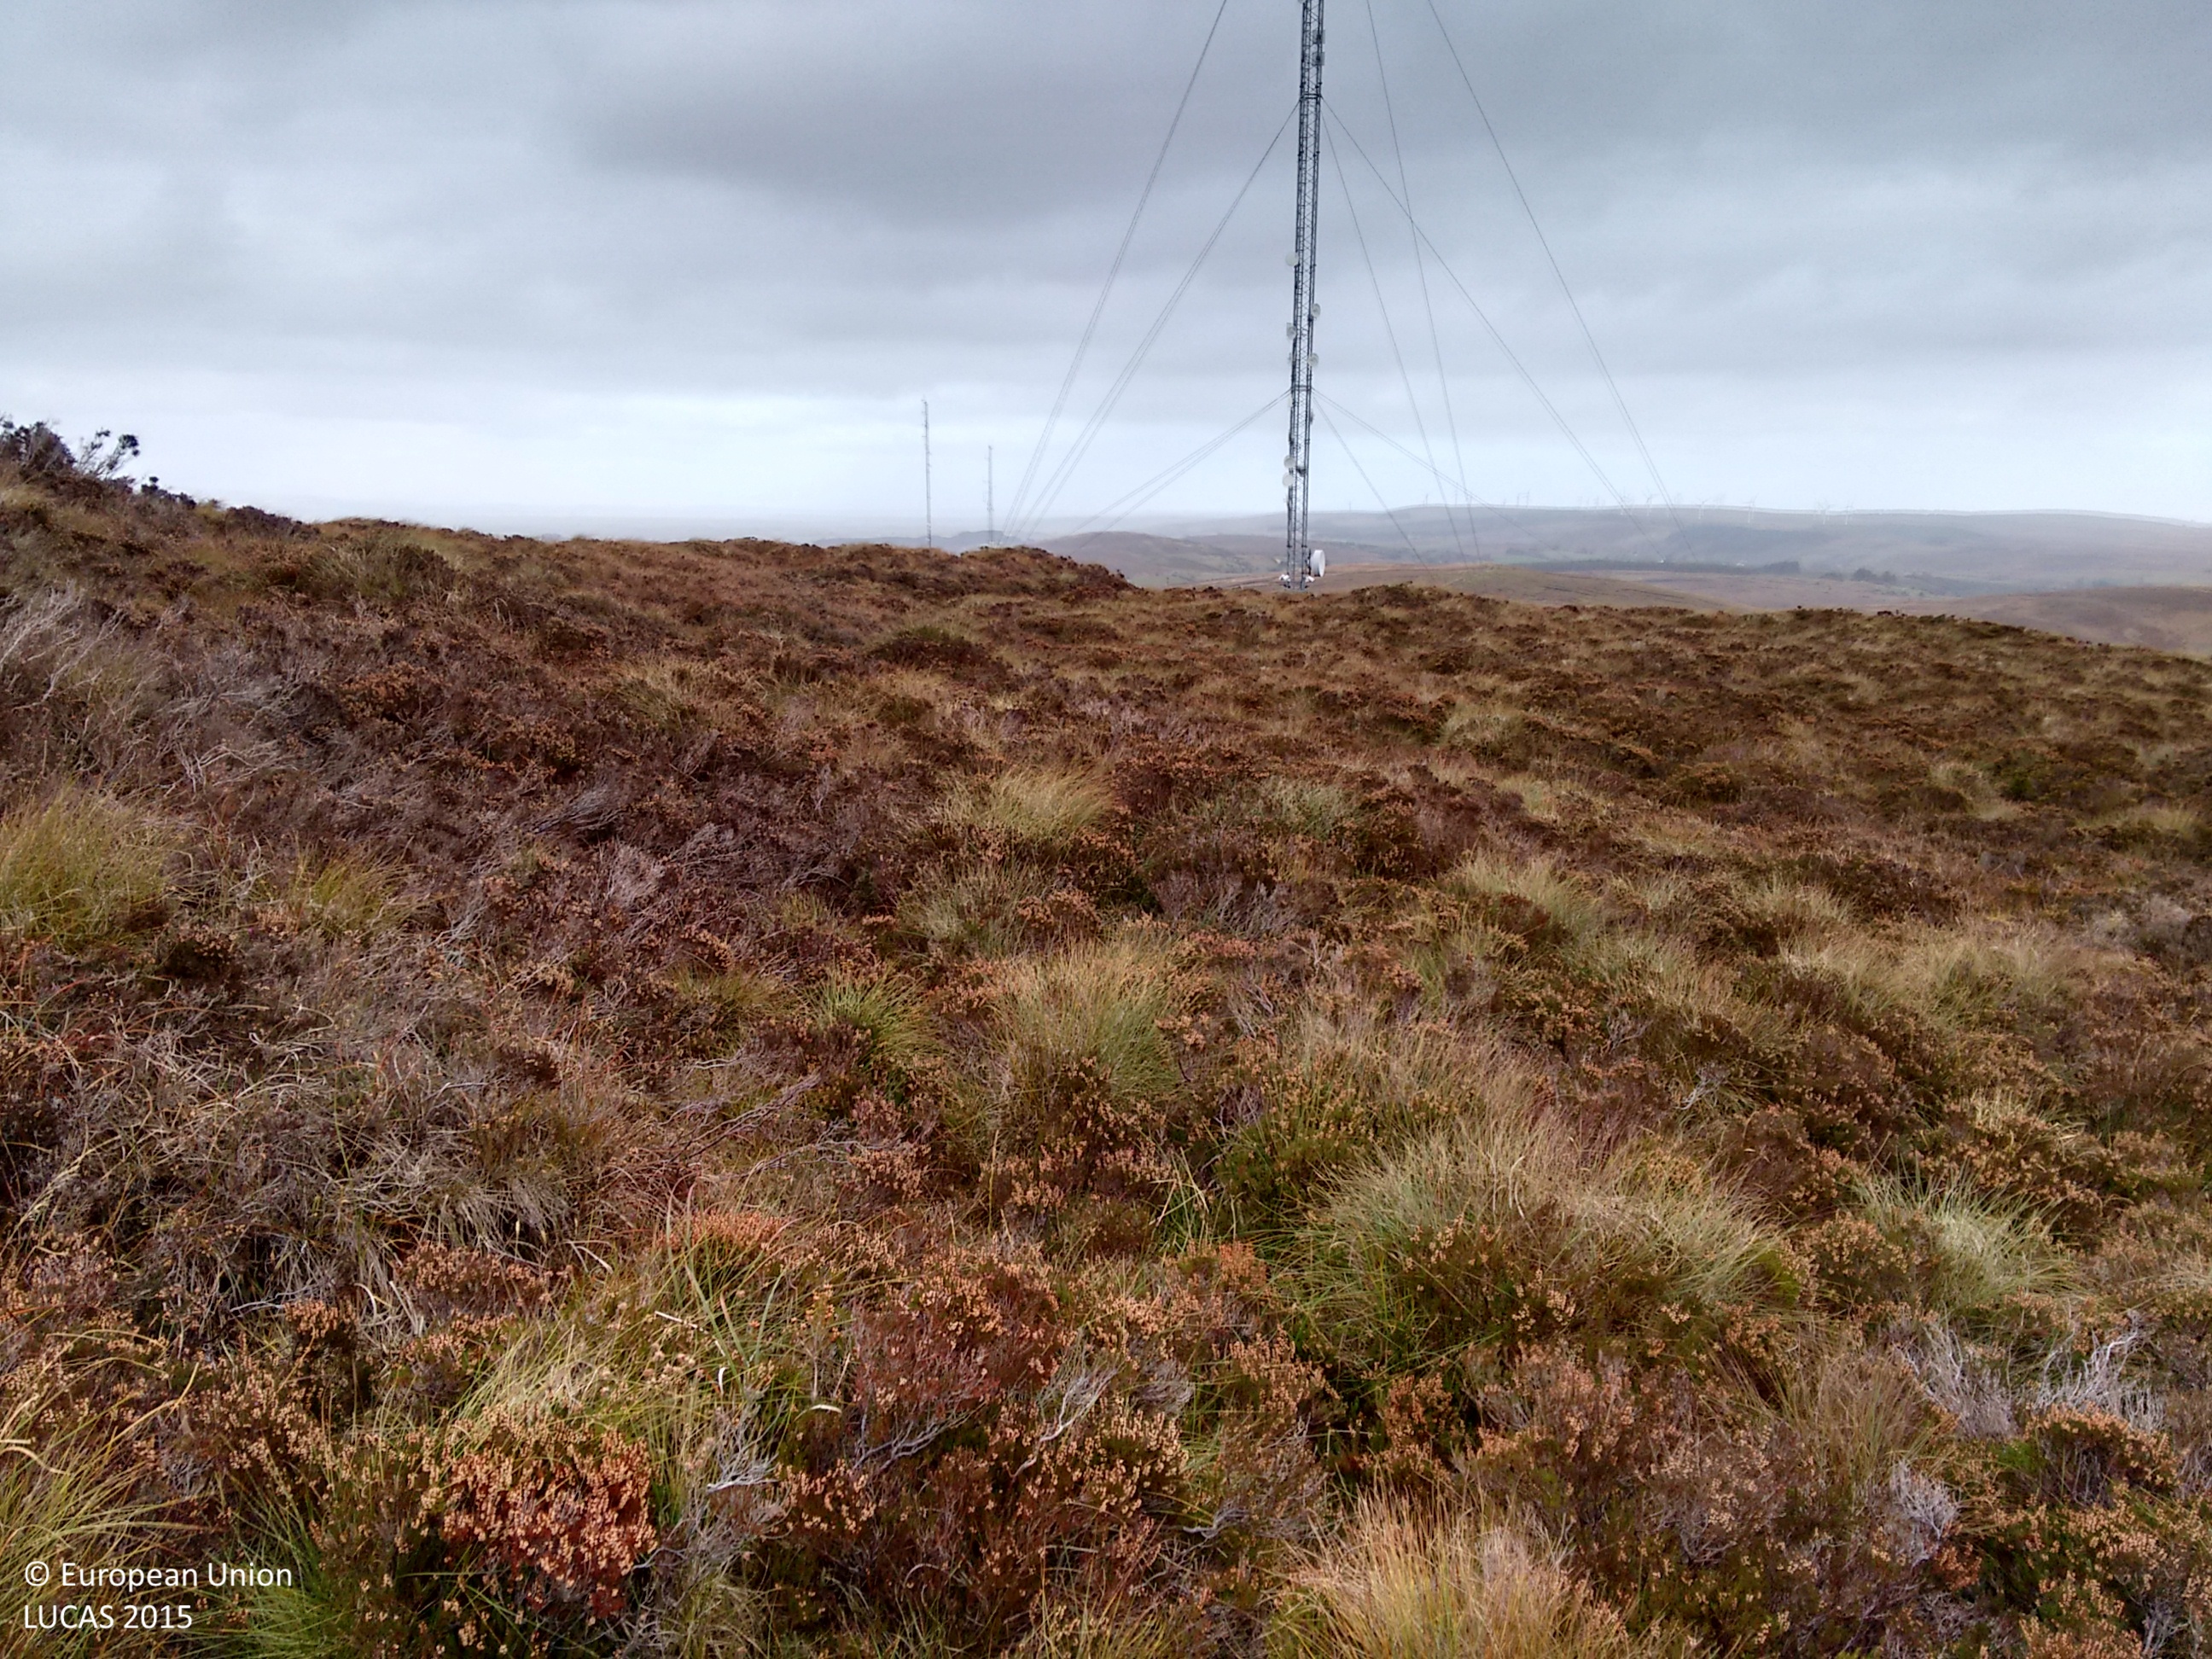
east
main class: Shrubland
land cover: Shrubland without tree cover
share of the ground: > 75 %
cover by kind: shrubs 80 %, lichens and mosses 20 %
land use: Agriculture (excluding fallow land and kitchen gardens)
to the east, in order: Shrubland without tree cover; Fences; Shrubland without tree cover; Fences; Grassland without tree/shrub cover
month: October
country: GB
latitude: 54.4223
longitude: -7.4626
